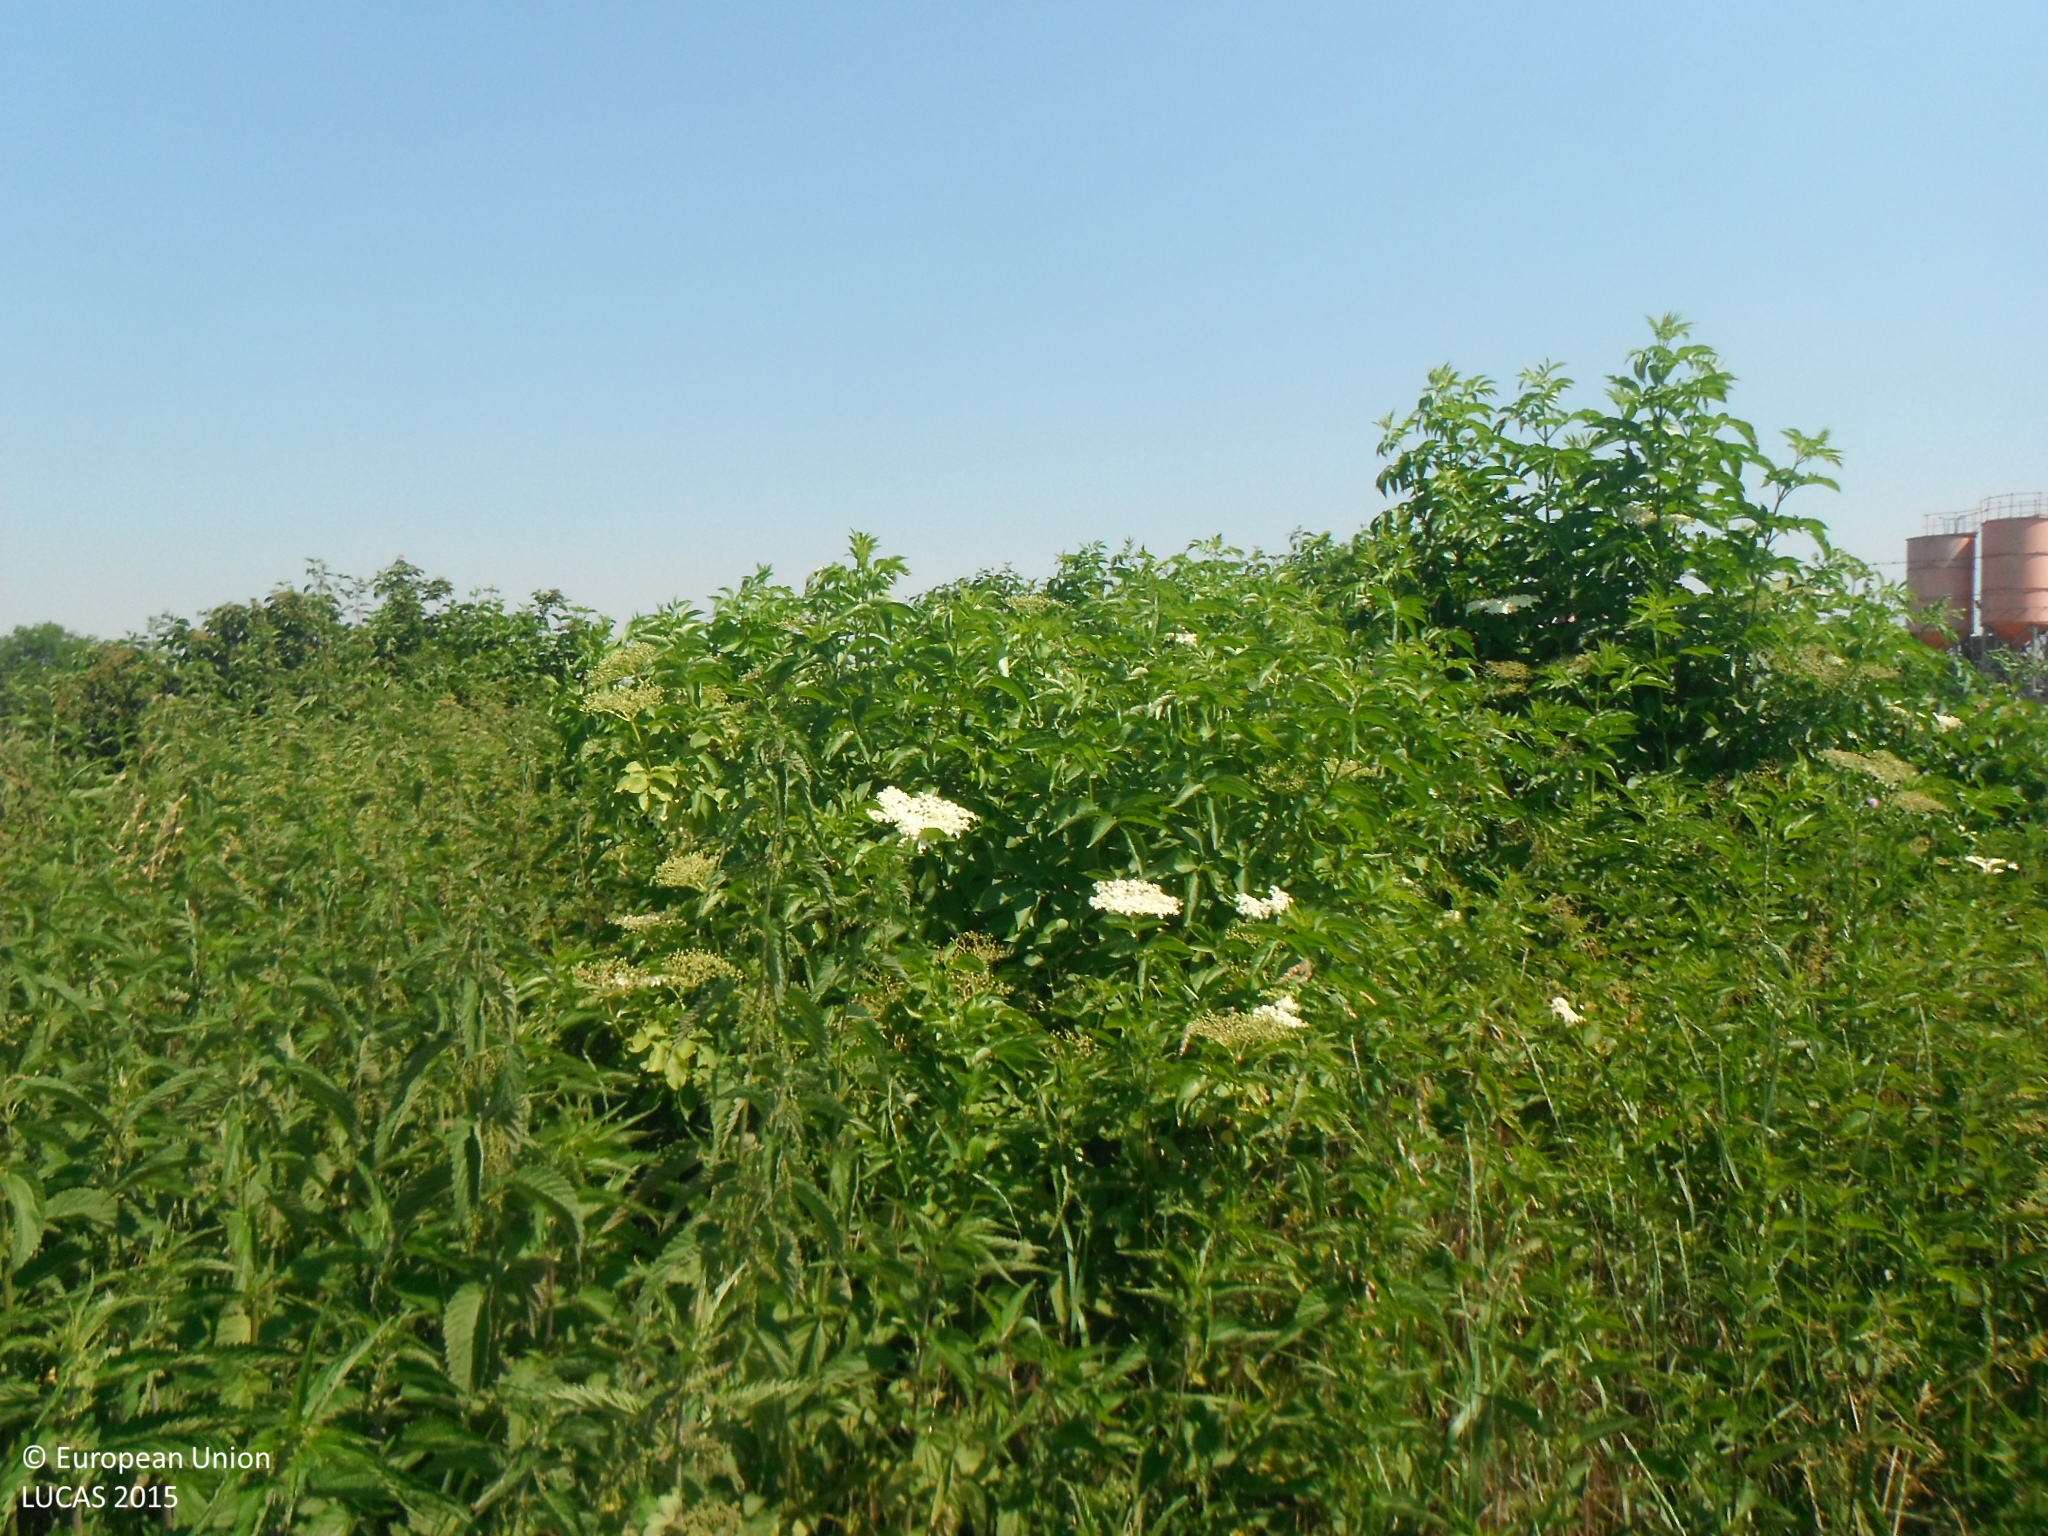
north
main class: Shrubland
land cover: Shrubland without tree cover
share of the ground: > 75 %
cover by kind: herbaceous plants 80 %, shrubs 20 %
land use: Abandoned areas
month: June
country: SK
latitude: 48.0454
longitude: 17.9399
